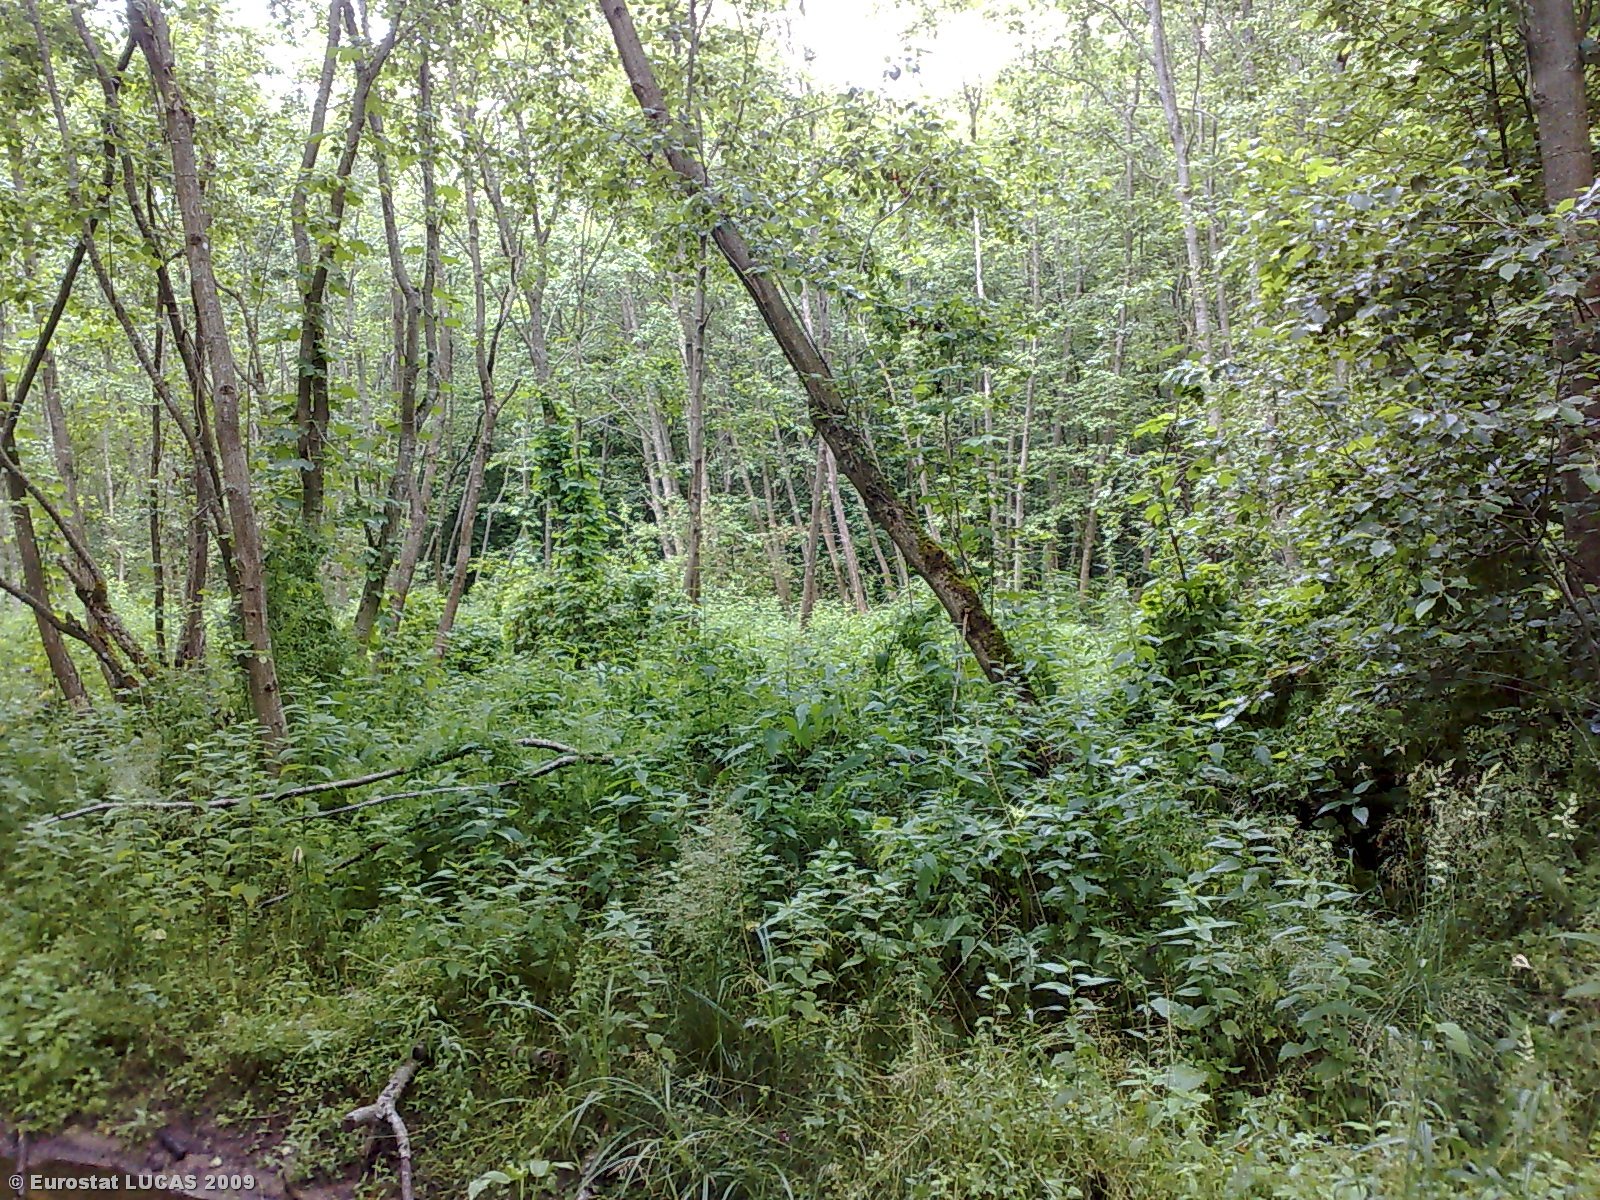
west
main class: Woodland
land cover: Broadleaved woodland
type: floodplain forest
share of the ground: > 75 %
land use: Forestry
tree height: > 5 m
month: July
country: LT
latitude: 55.6916
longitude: 22.7756
